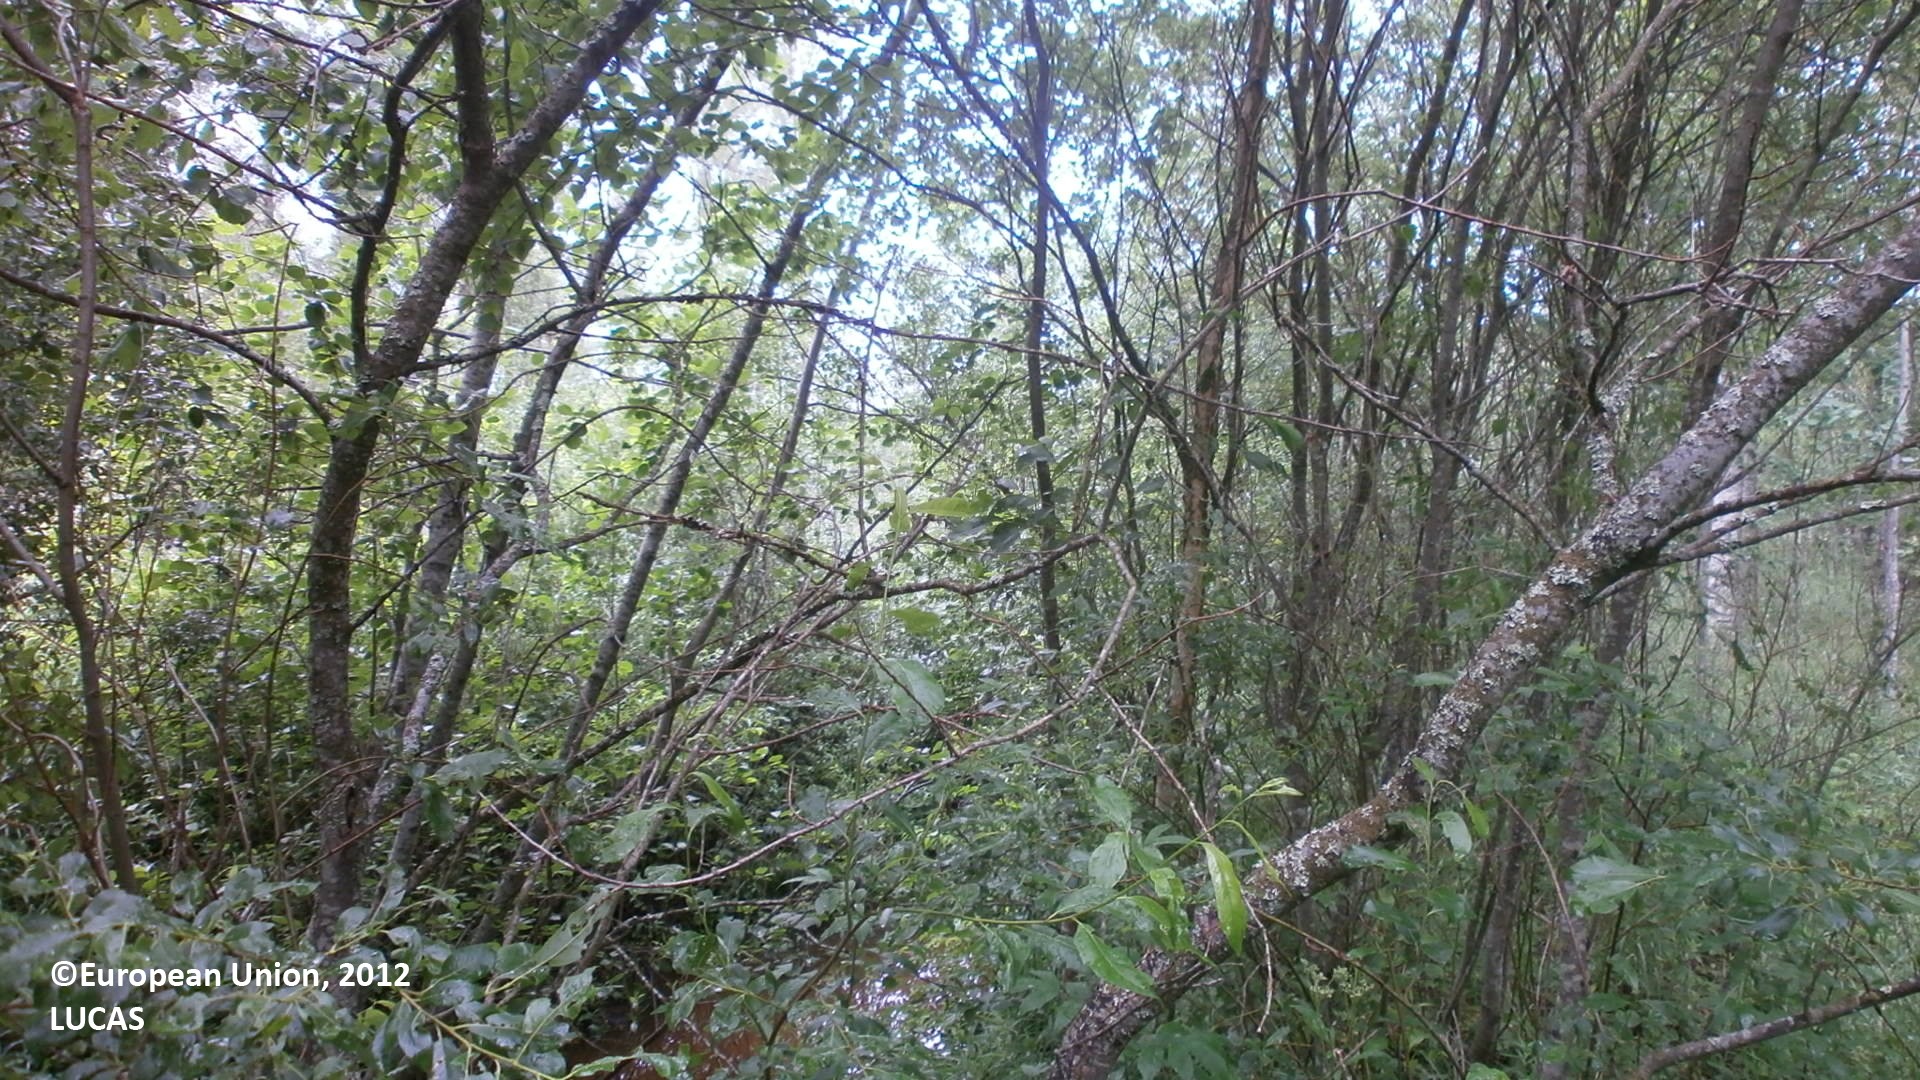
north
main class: Woodland
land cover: Spruce dominated mixed woodland
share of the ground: 50 - 75 %
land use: Forestry
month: July
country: FI
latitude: 64.6601
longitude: 24.5810
